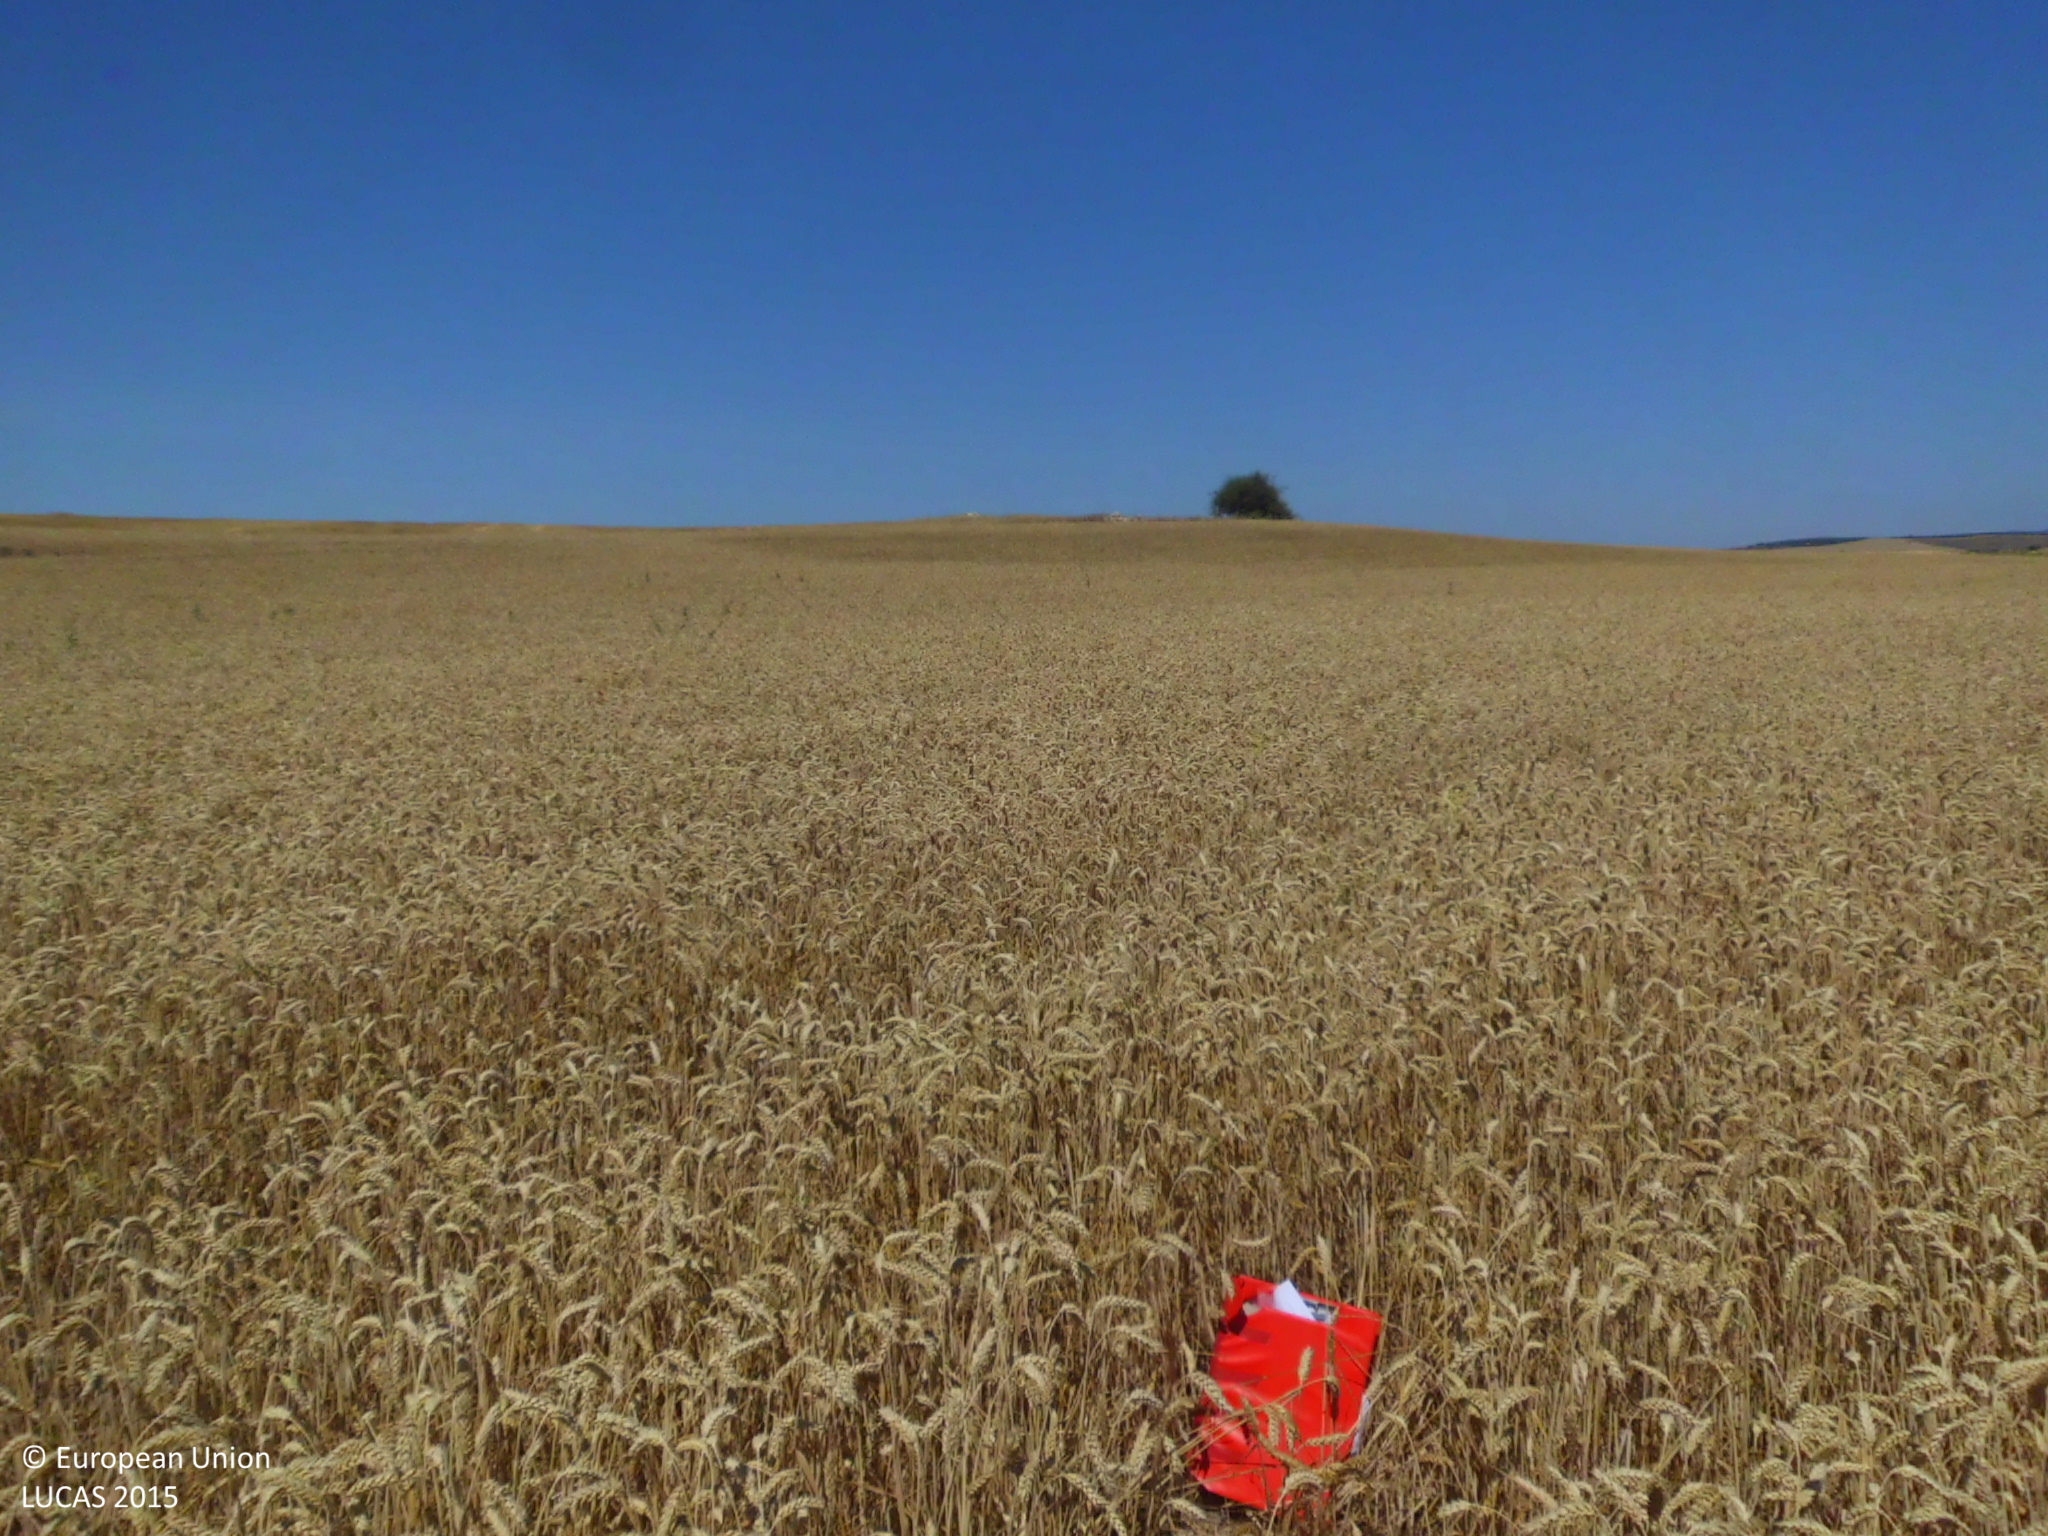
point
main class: Cropland
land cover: Common wheat
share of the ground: 50 - 75 %
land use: Agriculture (excluding fallow land and kitchen gardens)
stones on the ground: < 10 %
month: July
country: ES
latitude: 42.2027
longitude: -3.6348
